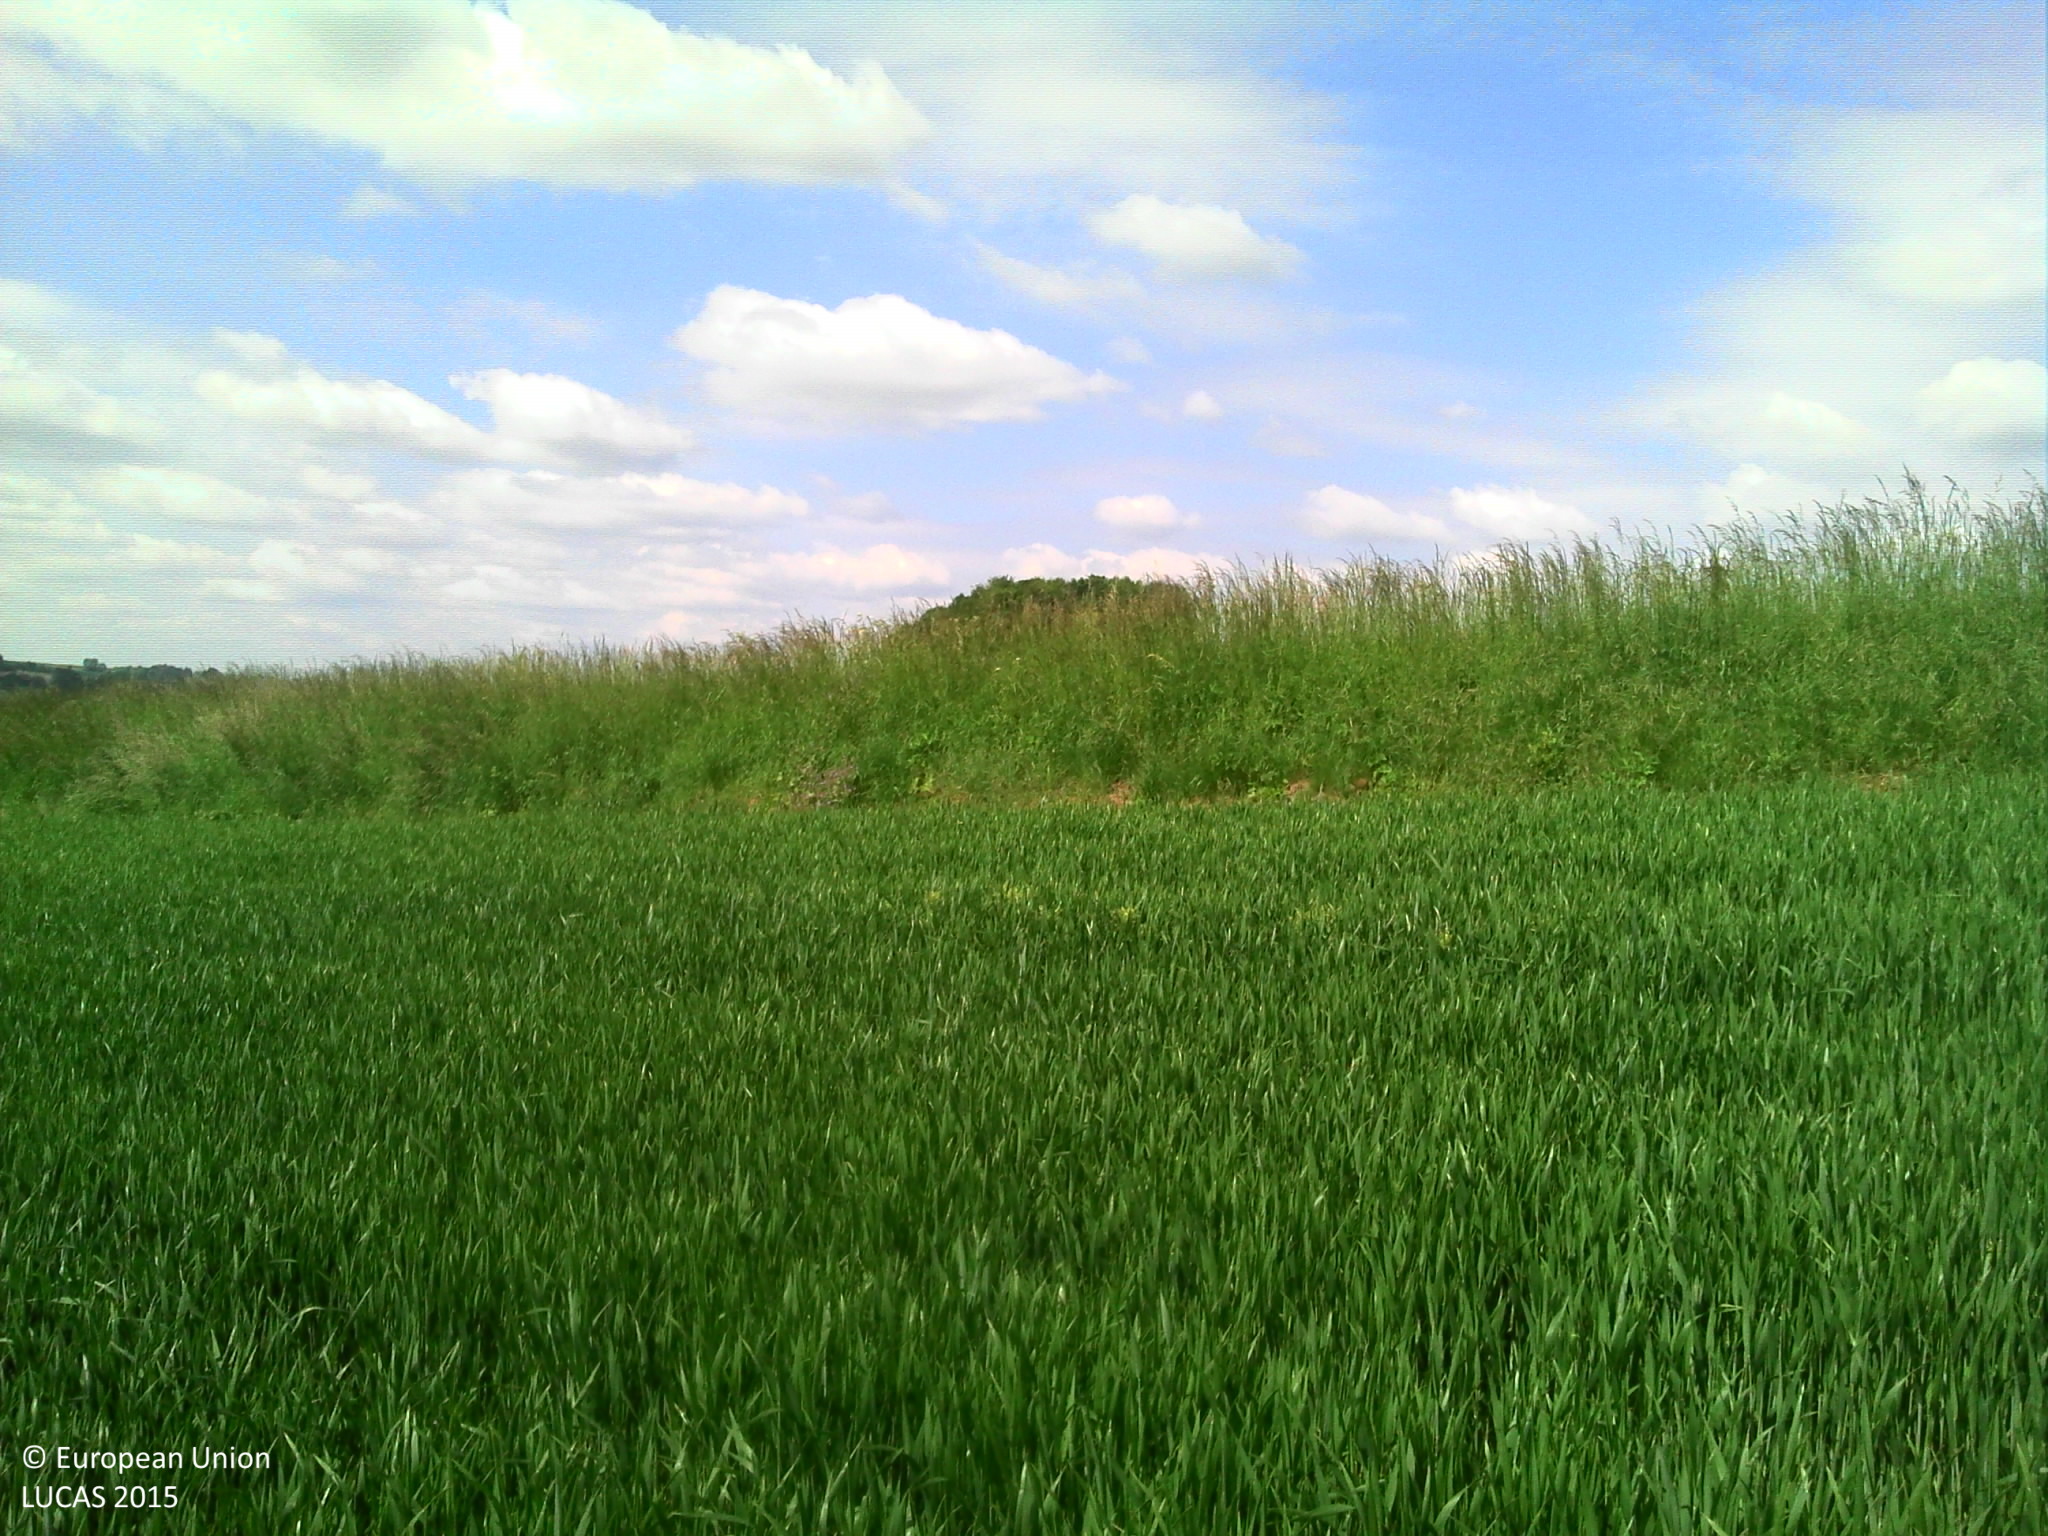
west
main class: Cropland
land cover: Common wheat
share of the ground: > 75 %
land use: Agriculture (excluding fallow land and kitchen gardens)
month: May
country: BE
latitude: 50.4612
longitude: 5.1940
